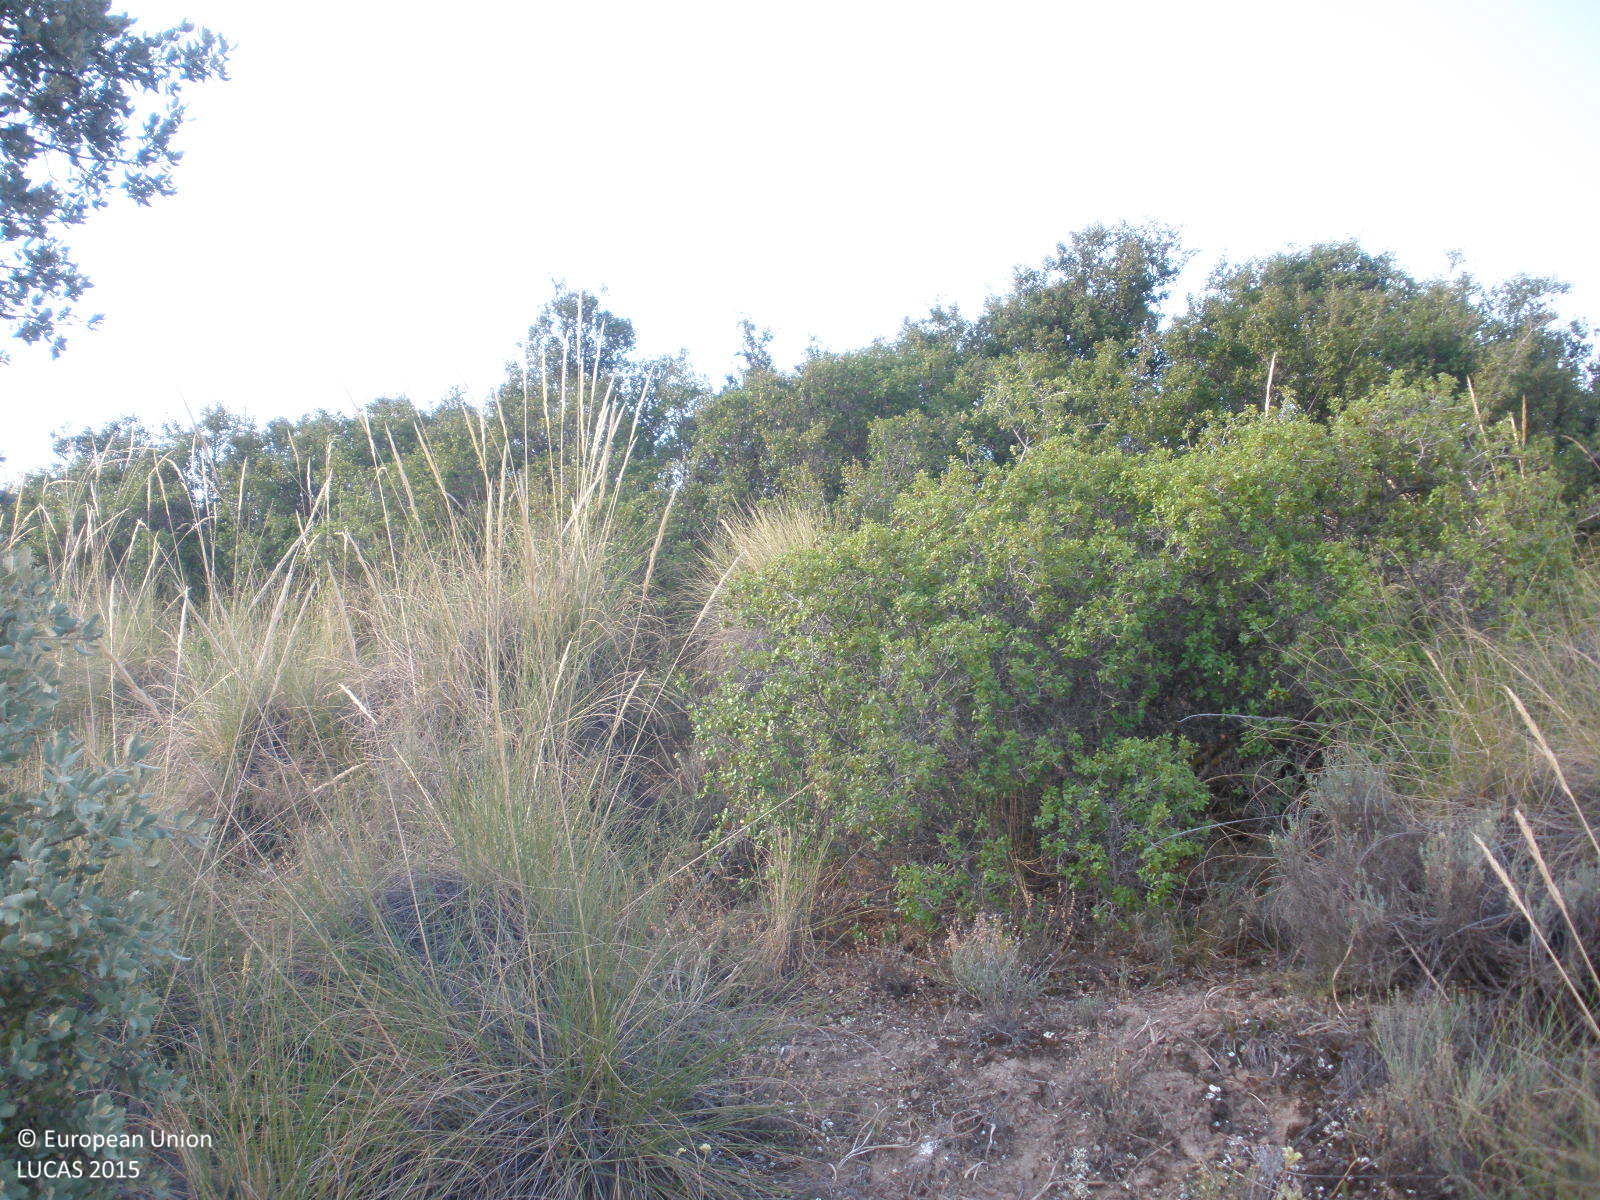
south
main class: Woodland
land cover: Broadleaved woodland
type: broadleaved evergreen forest
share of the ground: 10 - 25 %
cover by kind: shrubs 40 %, herbaceous plants 30 %, broadleaved forest trees 20 %, consolidated bare surface 10 %
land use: Semi-natural and natural areas not in use
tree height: < 5 m
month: July
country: ES
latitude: 40.0214
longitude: -3.3975
